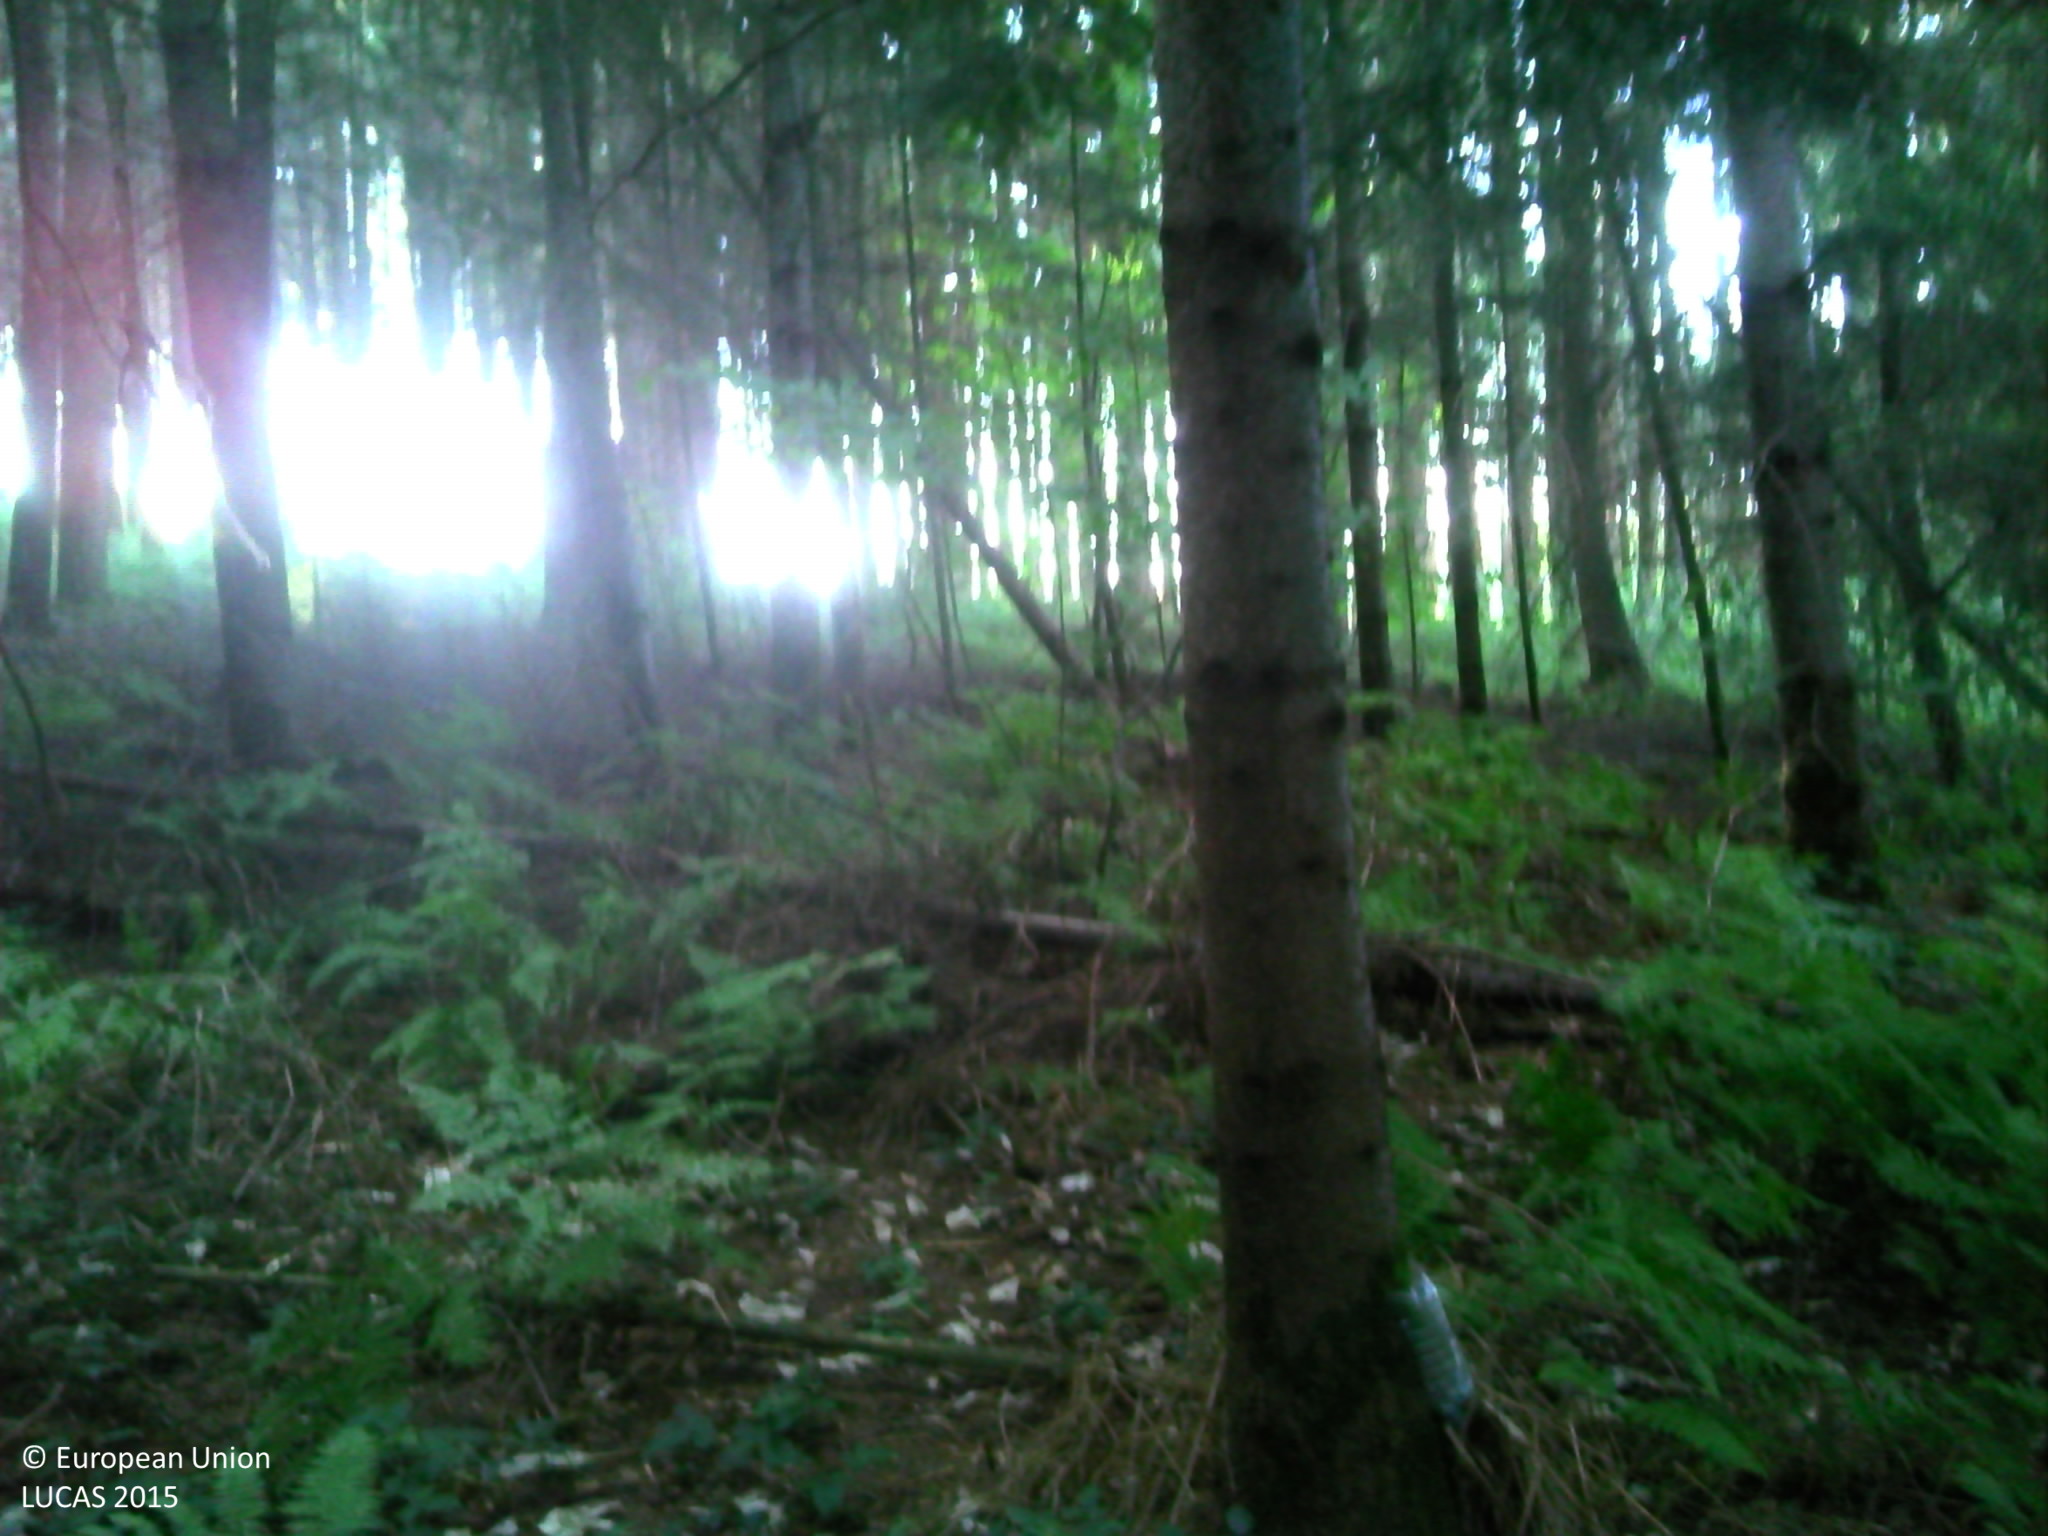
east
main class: Woodland
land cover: Spruce dominated coniferous woodland
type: exotic forest
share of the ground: > 75 %
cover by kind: coniferous forest trees 80 %, herbaceous plants 20 %
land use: Forestry
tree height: > 5 m
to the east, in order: Spruce dominated coniferous woodland; Other mixed woodland; Tracks; Other mixed woodland; Spontaneously vegetated surfaces
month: June
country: FR
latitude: 46.3862
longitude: 4.4231
